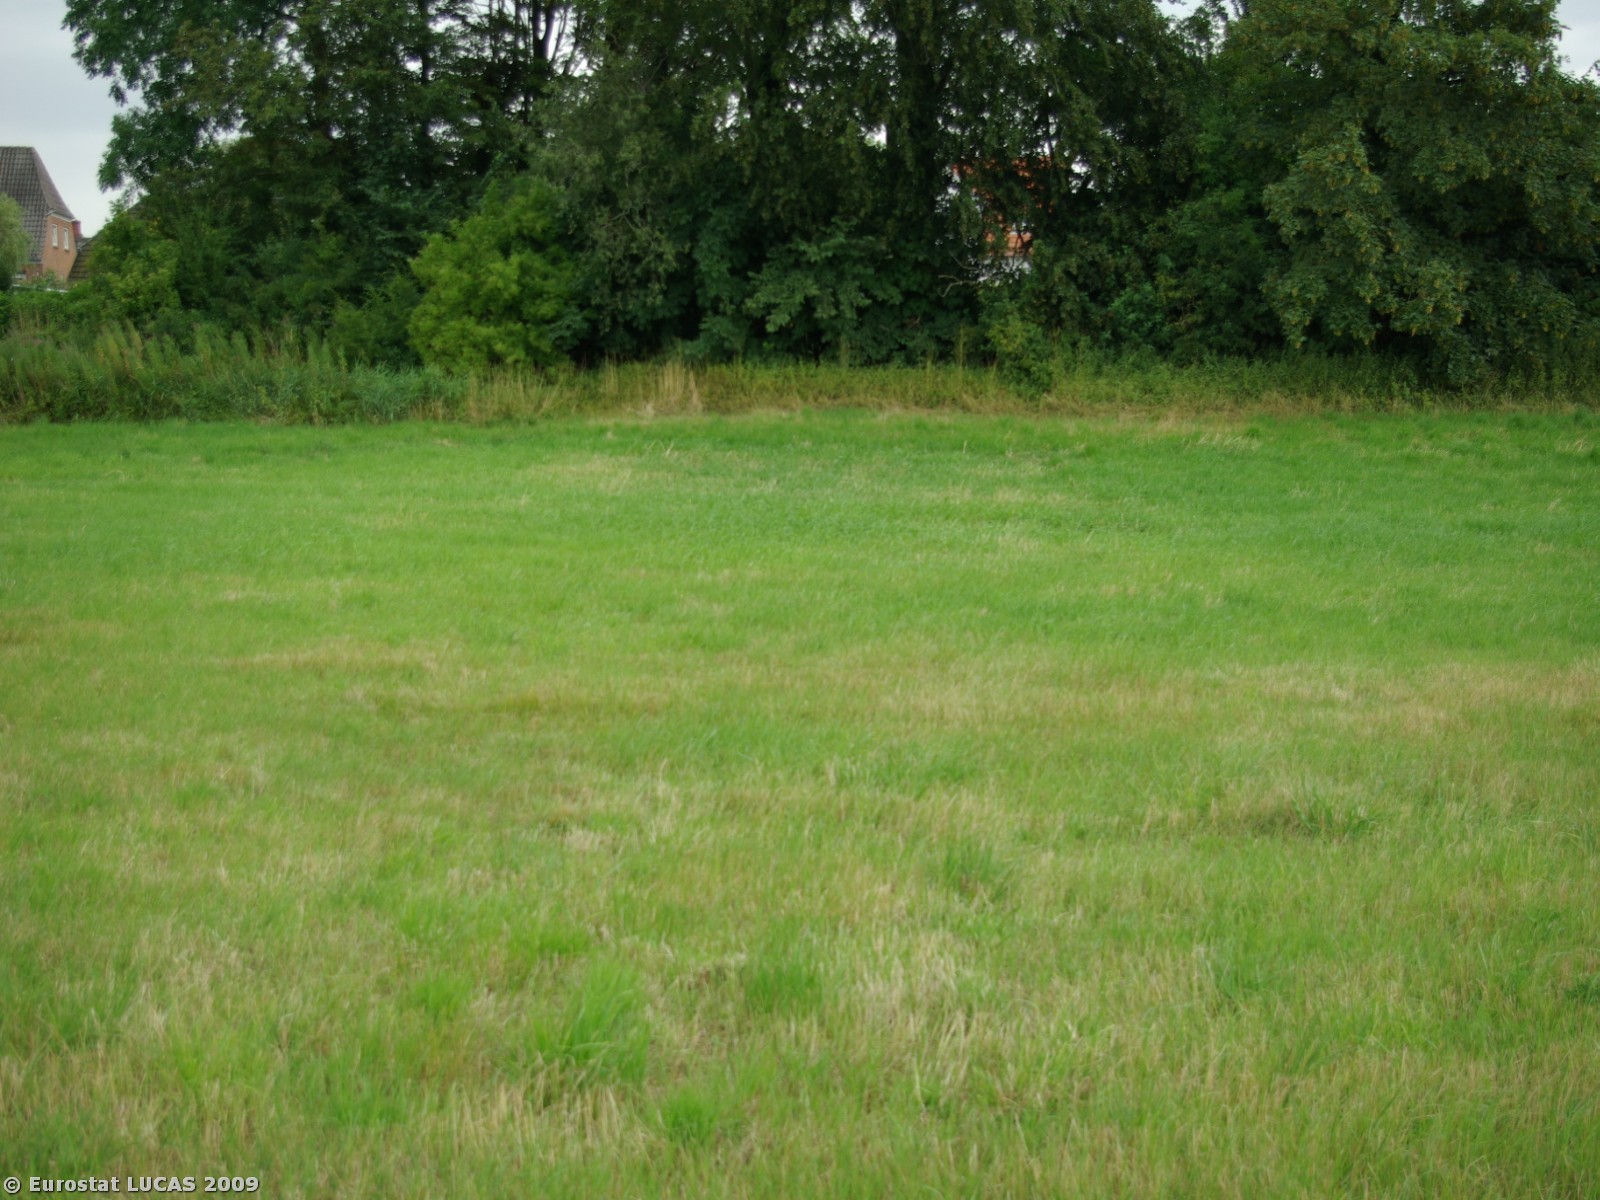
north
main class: Grassland
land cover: Grassland without tree/shrub cover
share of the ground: > 75 %
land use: Agriculture (excluding fallow land and kitchen gardens)
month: July
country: DK
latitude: 55.1927
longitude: 8.7286
